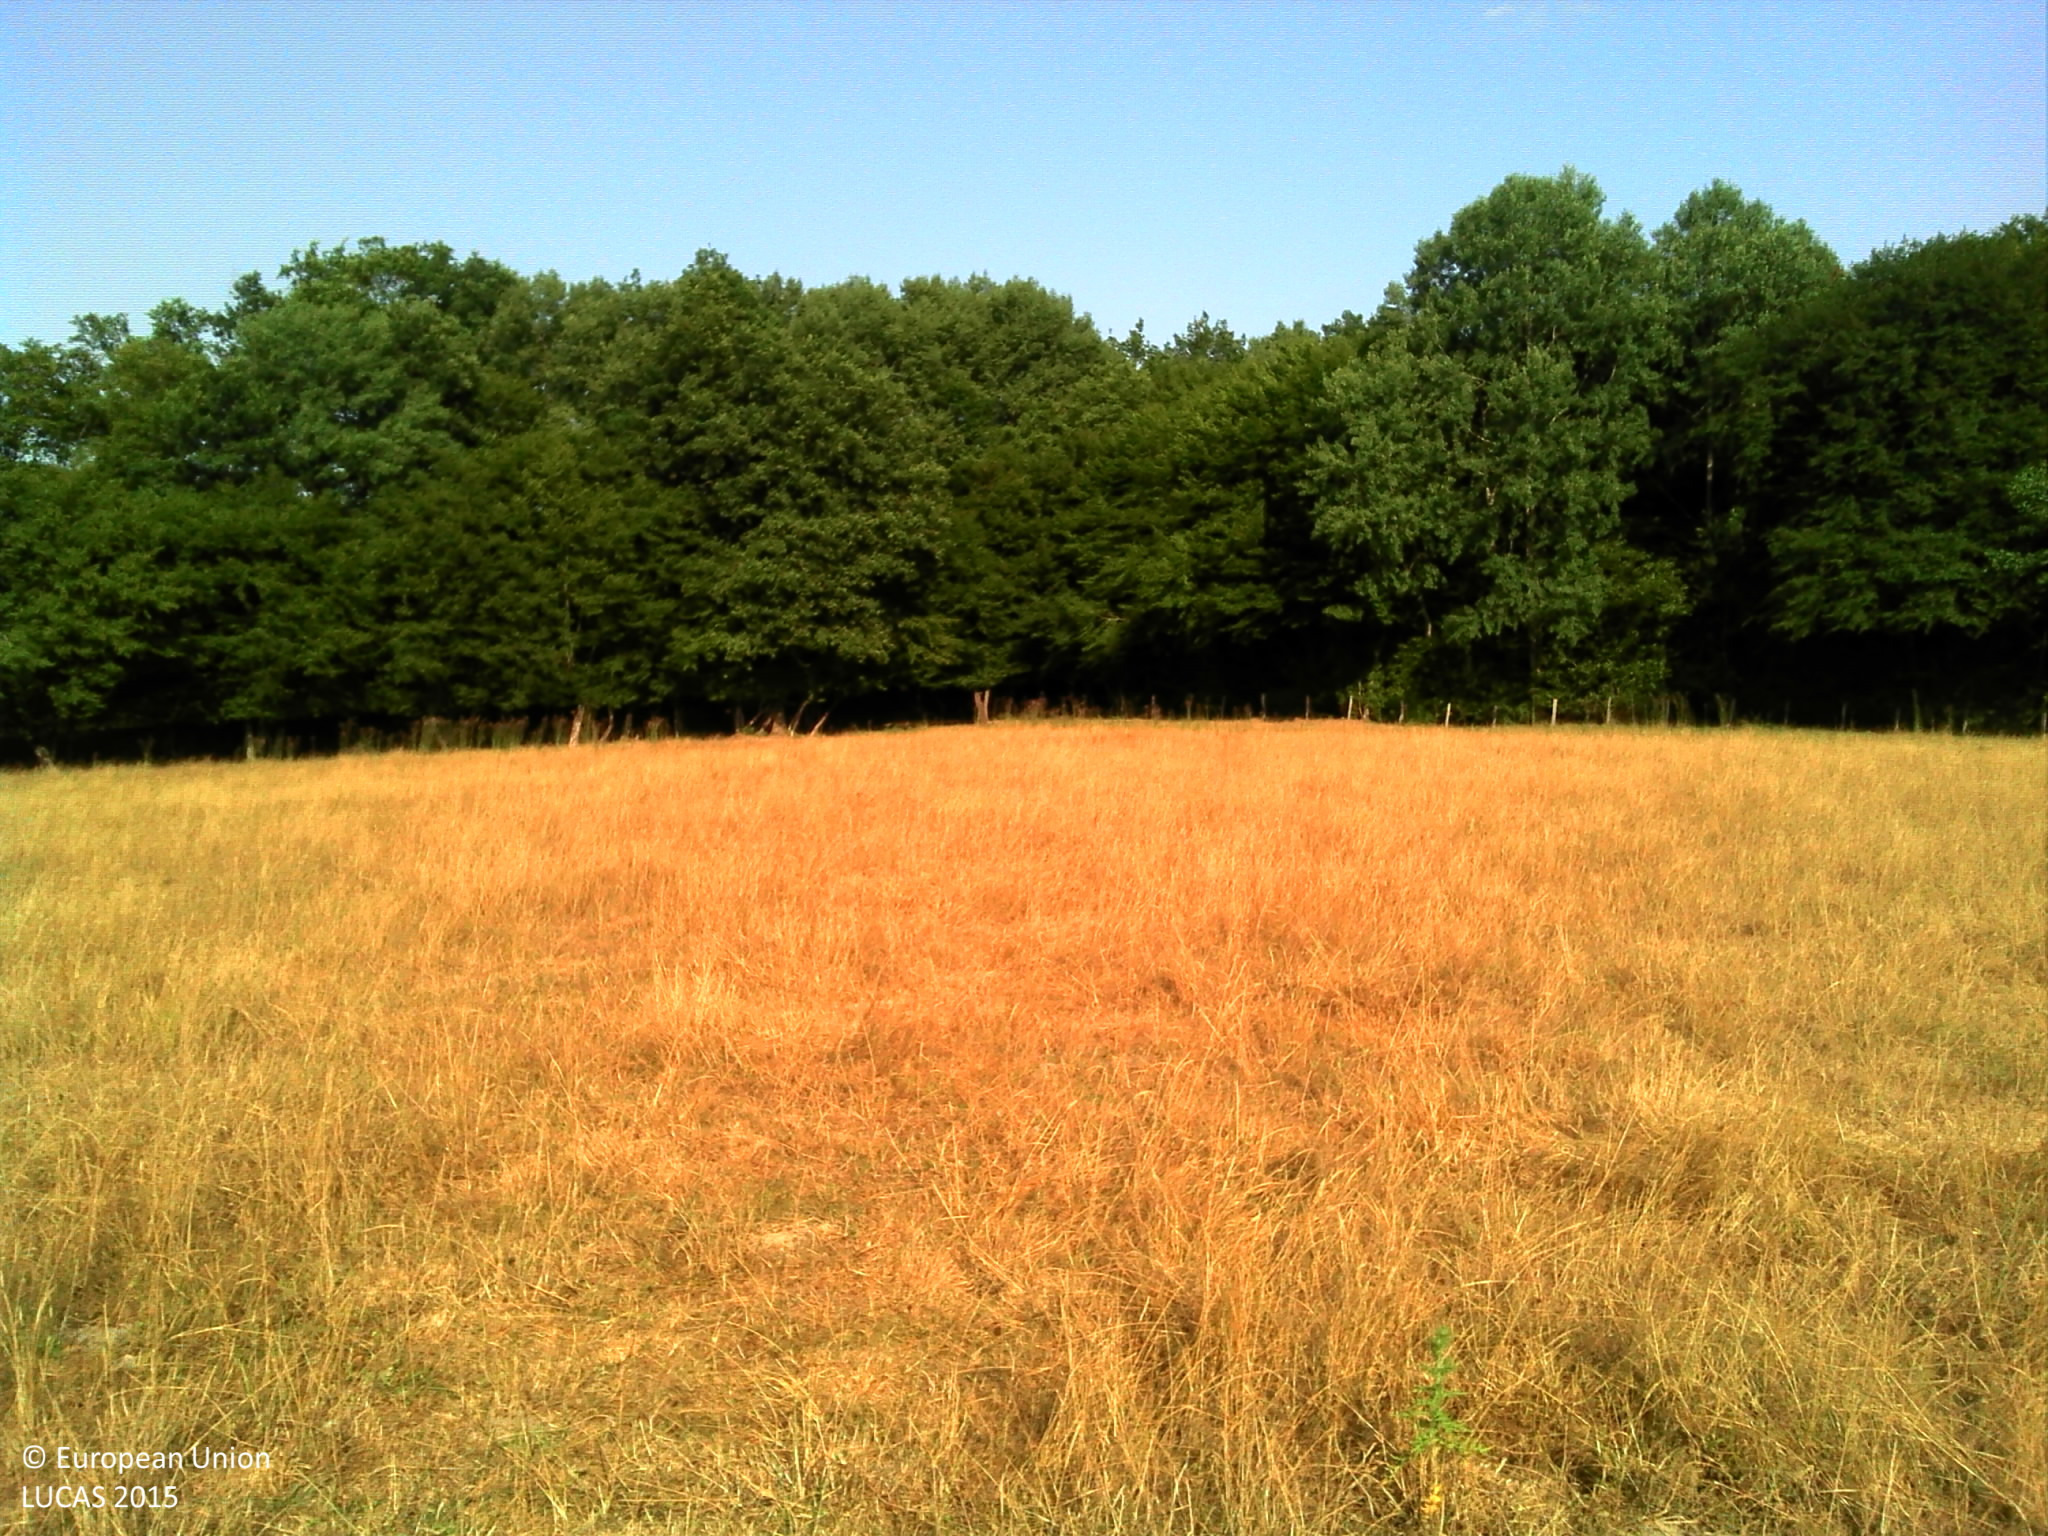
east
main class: Grassland
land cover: Grassland without tree/shrub cover
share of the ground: > 75 %
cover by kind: herbaceous plants 100 %
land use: Agriculture (excluding fallow land and kitchen gardens)
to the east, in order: Grassland without tree/shrub cover; Broadleaved woodland; Grassland without tree/shrub cover; Fences; Abandoned hedges; Grassland without tree/shrub cover; Abandoned hedges; Rivers and streams; Grassland without tree/shrub cover
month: July
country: FR
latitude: 46.8123
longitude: 3.6423
